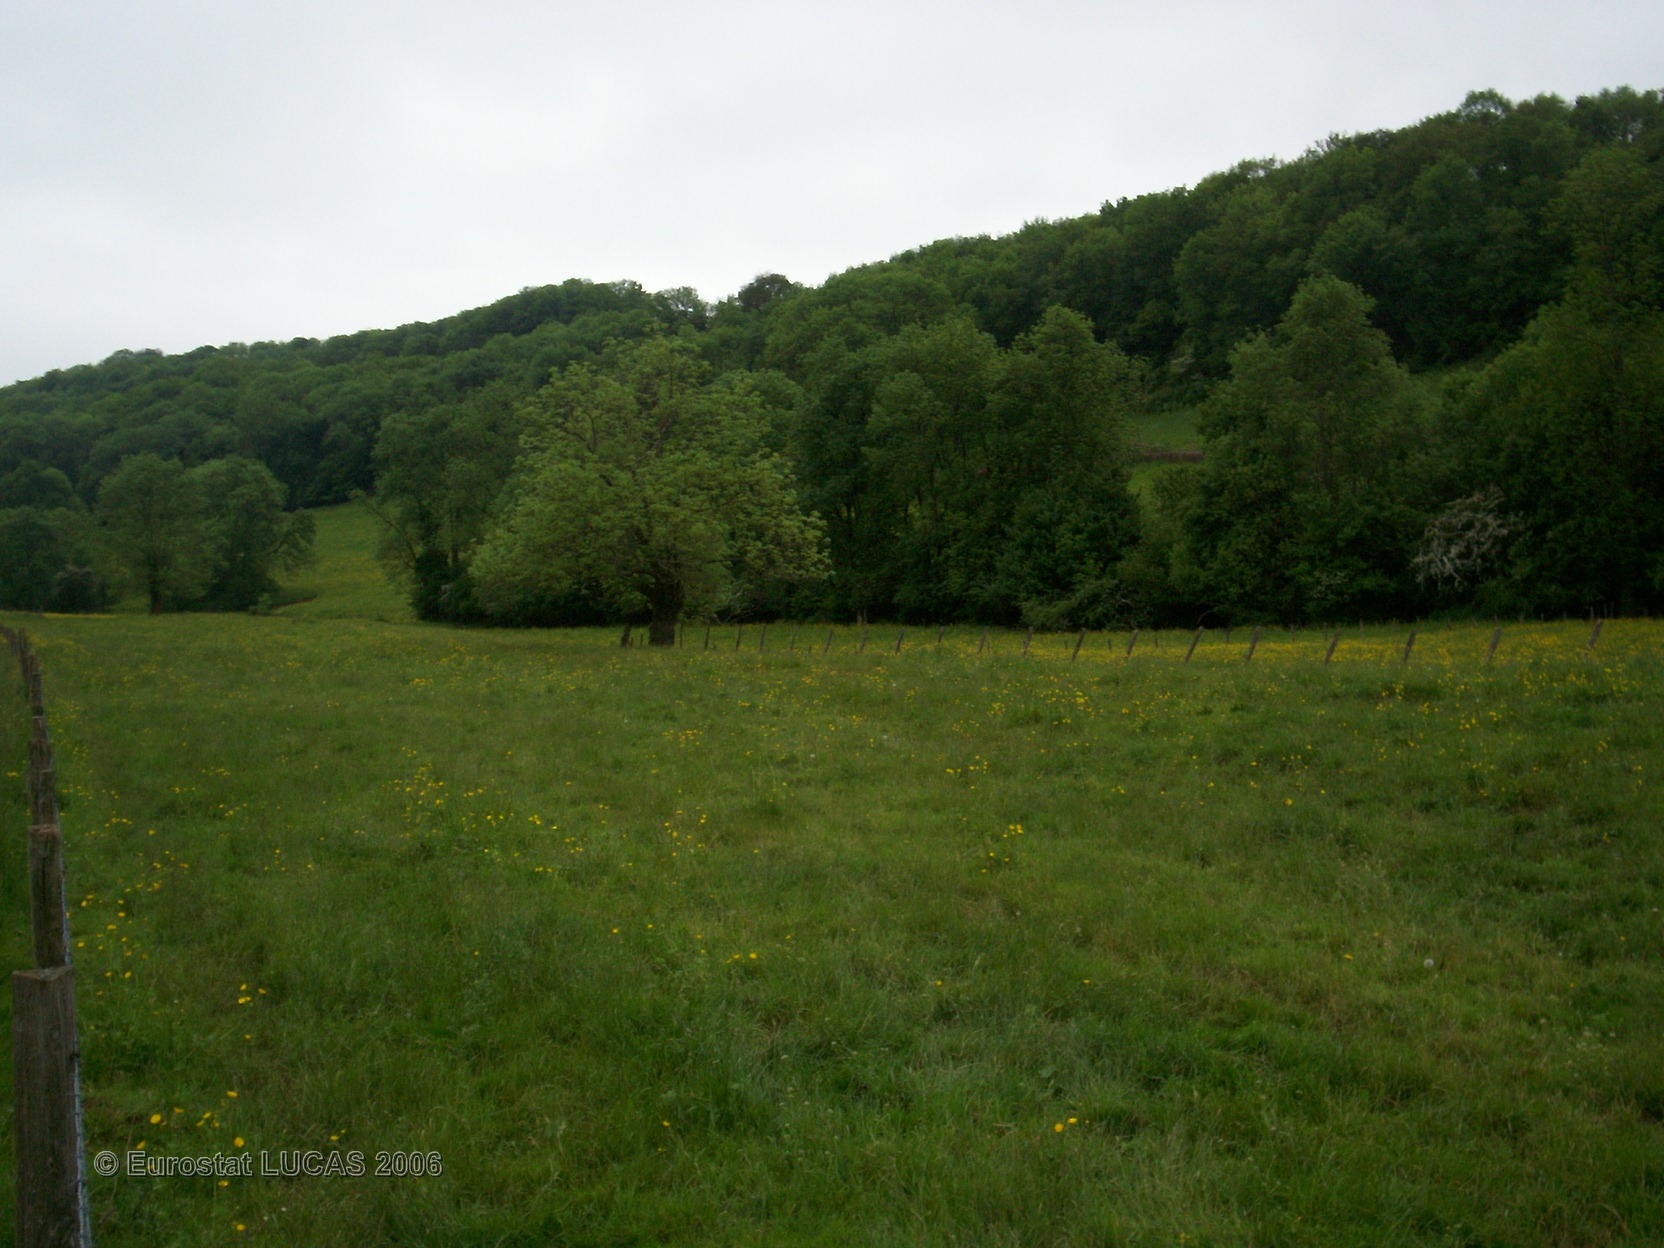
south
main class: Grassland
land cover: Grassland without tree/shrub cover
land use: Agriculture (excluding fallow land and kitchen gardens)
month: May
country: FR
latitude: 47.3728
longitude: 4.6626
